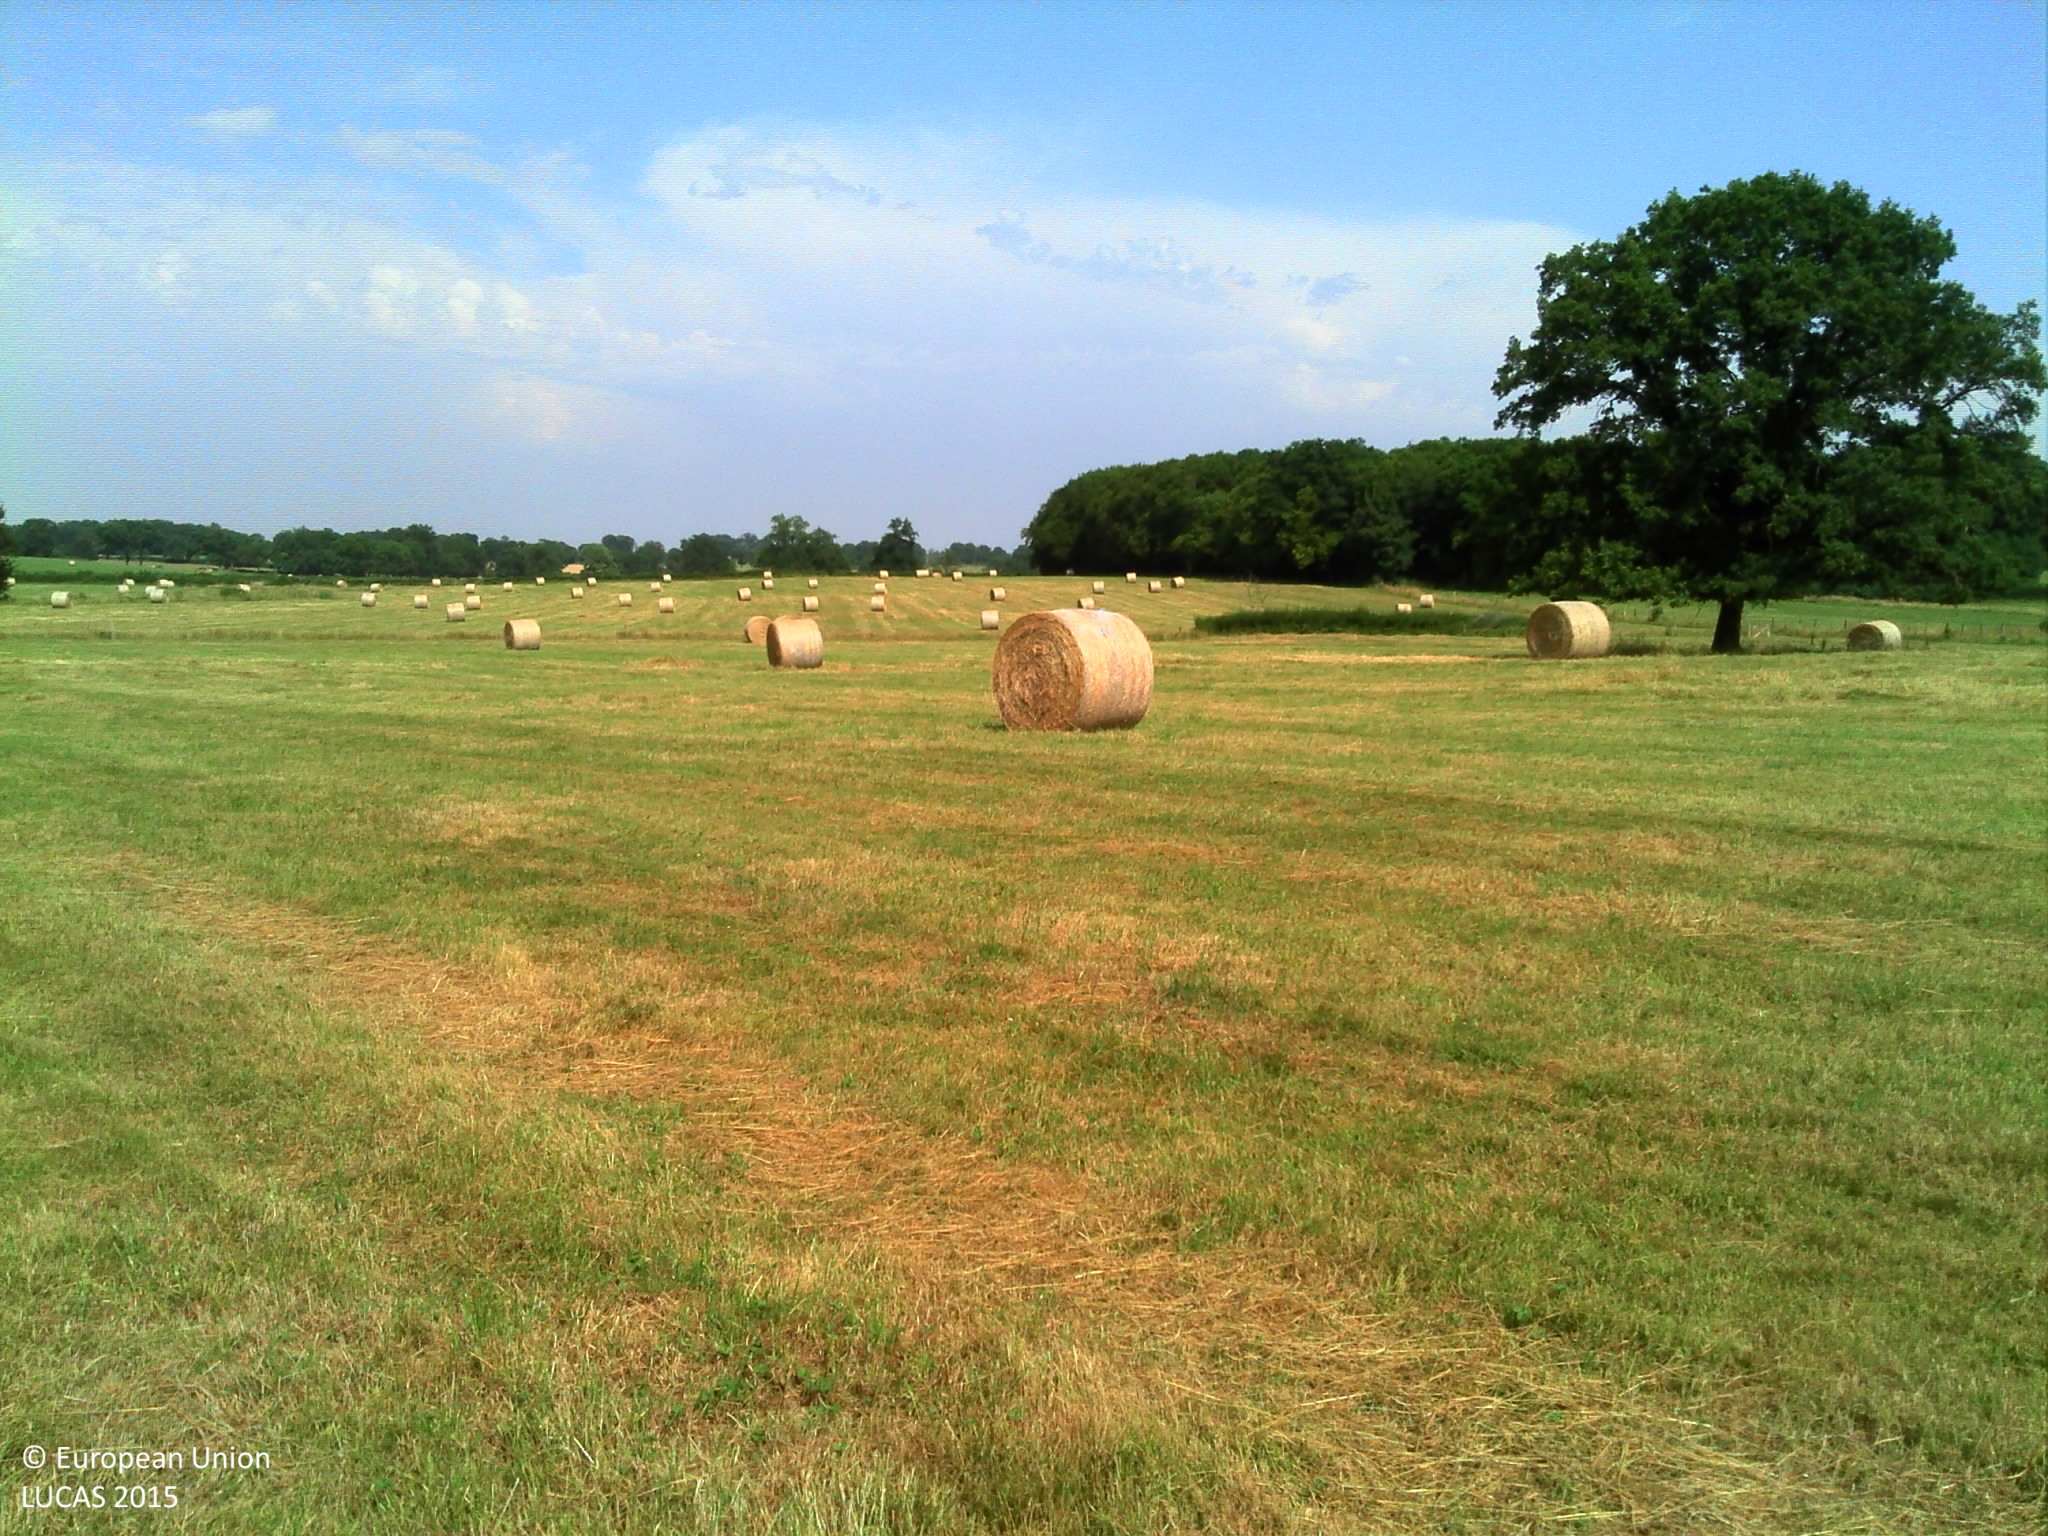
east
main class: Grassland
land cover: Grassland without tree/shrub cover
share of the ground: > 75 %
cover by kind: herbaceous plants 100 %
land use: Agriculture (excluding fallow land and kitchen gardens)
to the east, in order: Grassland without tree/shrub cover; Fences; Ditches and canals; Fences; Grassland without tree/shrub cover
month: July
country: FR
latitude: 47.2379
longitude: 3.5109
